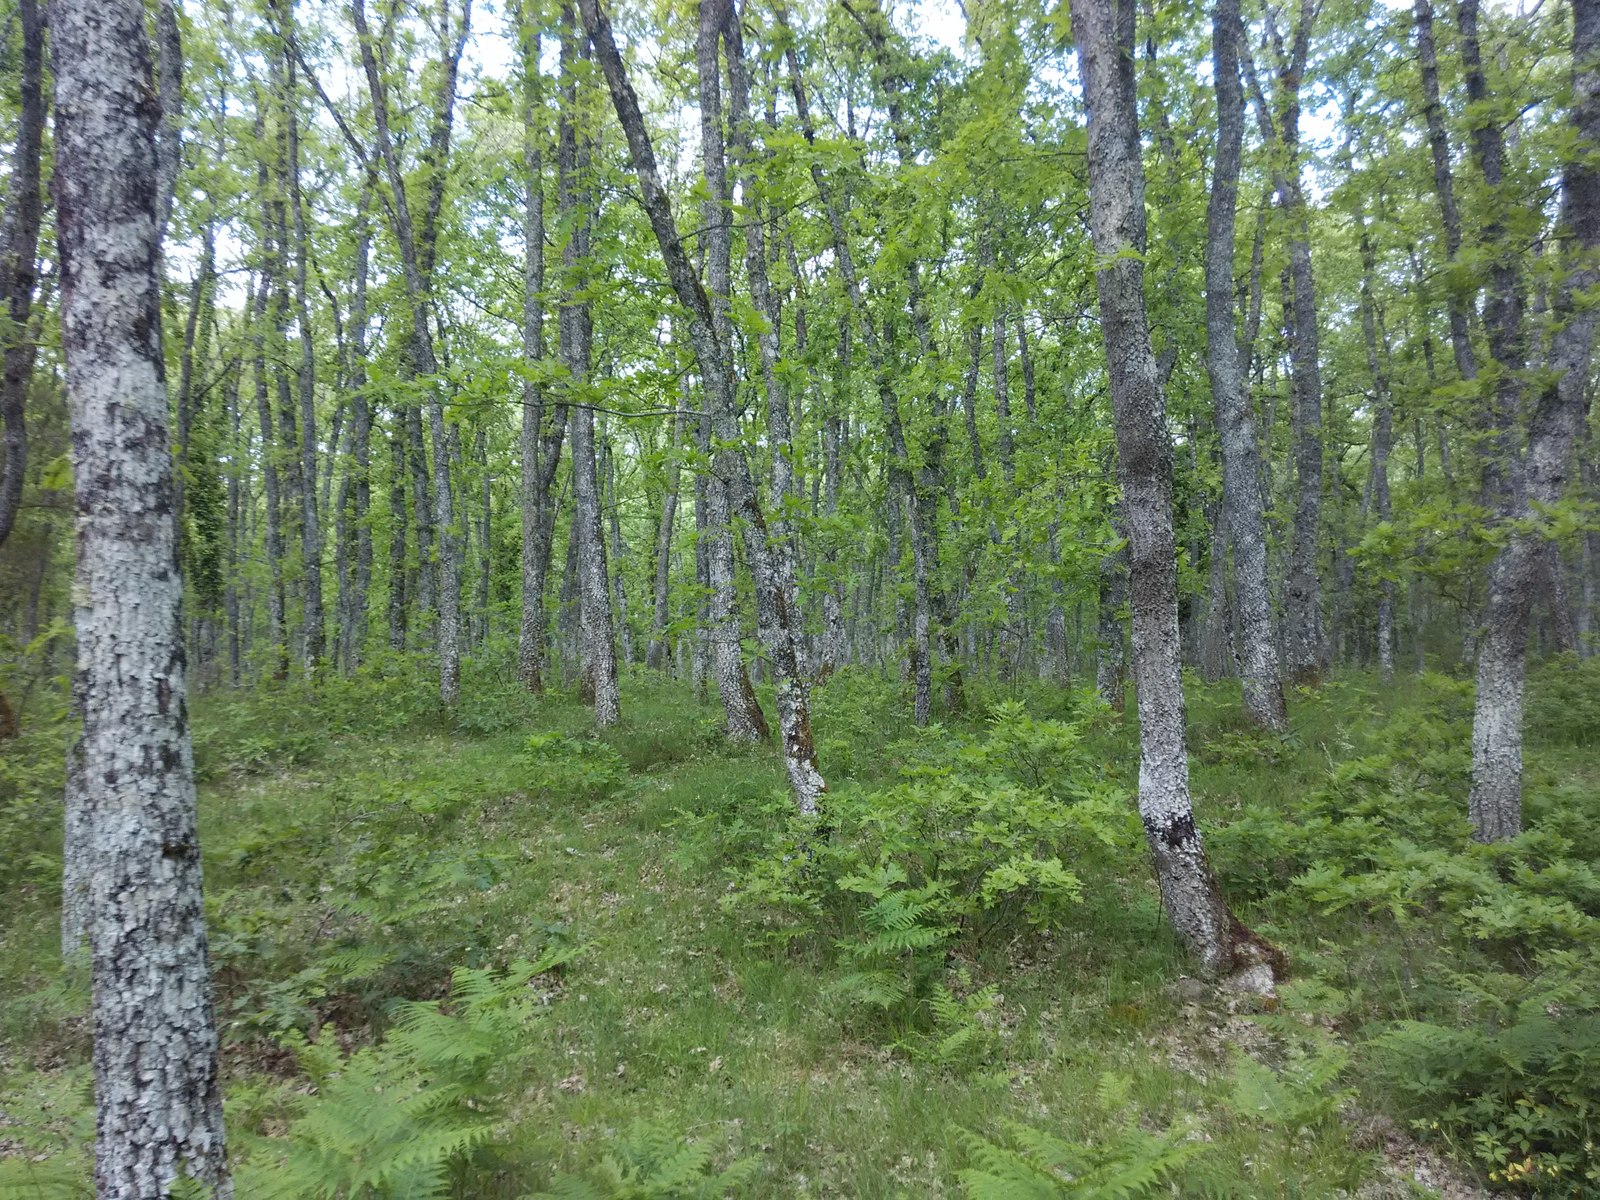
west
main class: Woodland
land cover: Broadleaved woodland
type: acidophilous oak and oak-birch forest
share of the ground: > 75 %
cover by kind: broadleaved forest trees 80 %, shrubs 10 %, herbaceous plants 10 %
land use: Forestry
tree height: > 5 m
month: June
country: ES
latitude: 42.9363
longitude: -2.4877
